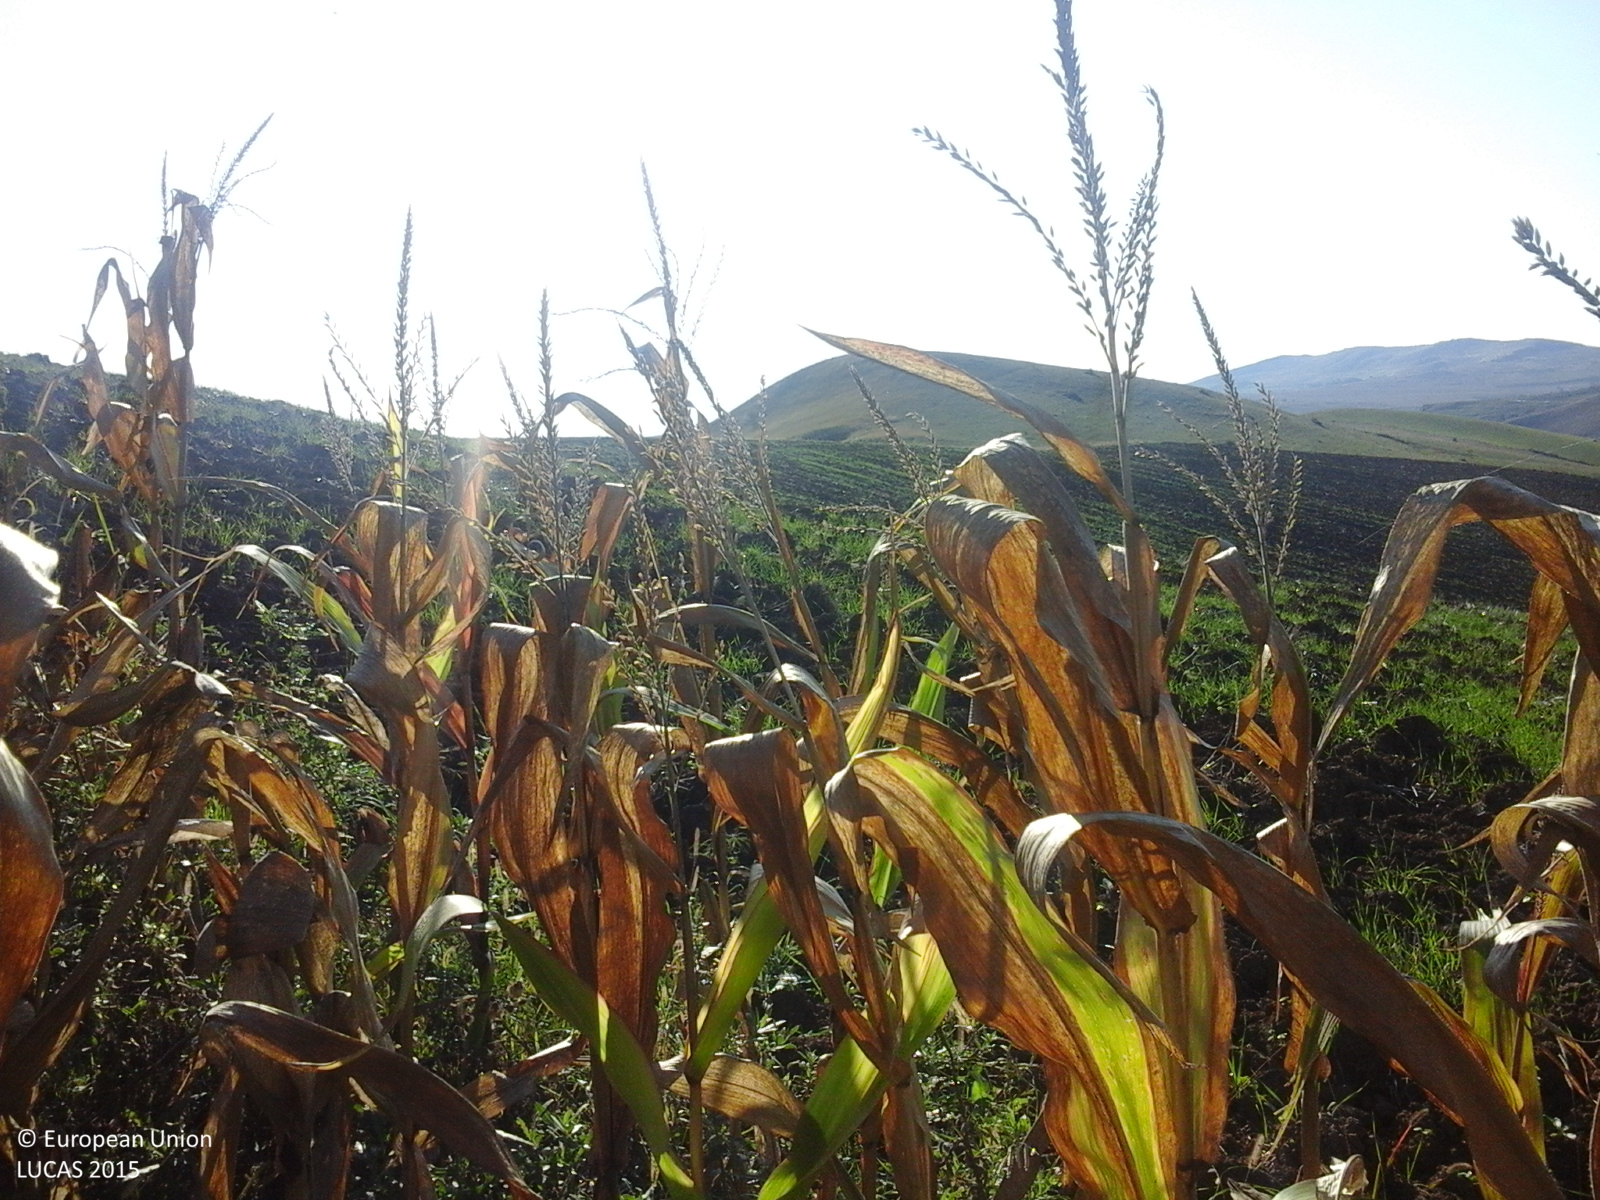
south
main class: Cropland
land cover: Maize
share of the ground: > 75 %
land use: Agriculture (excluding fallow land and kitchen gardens)
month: October
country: RO
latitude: 46.2262
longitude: 23.8809
